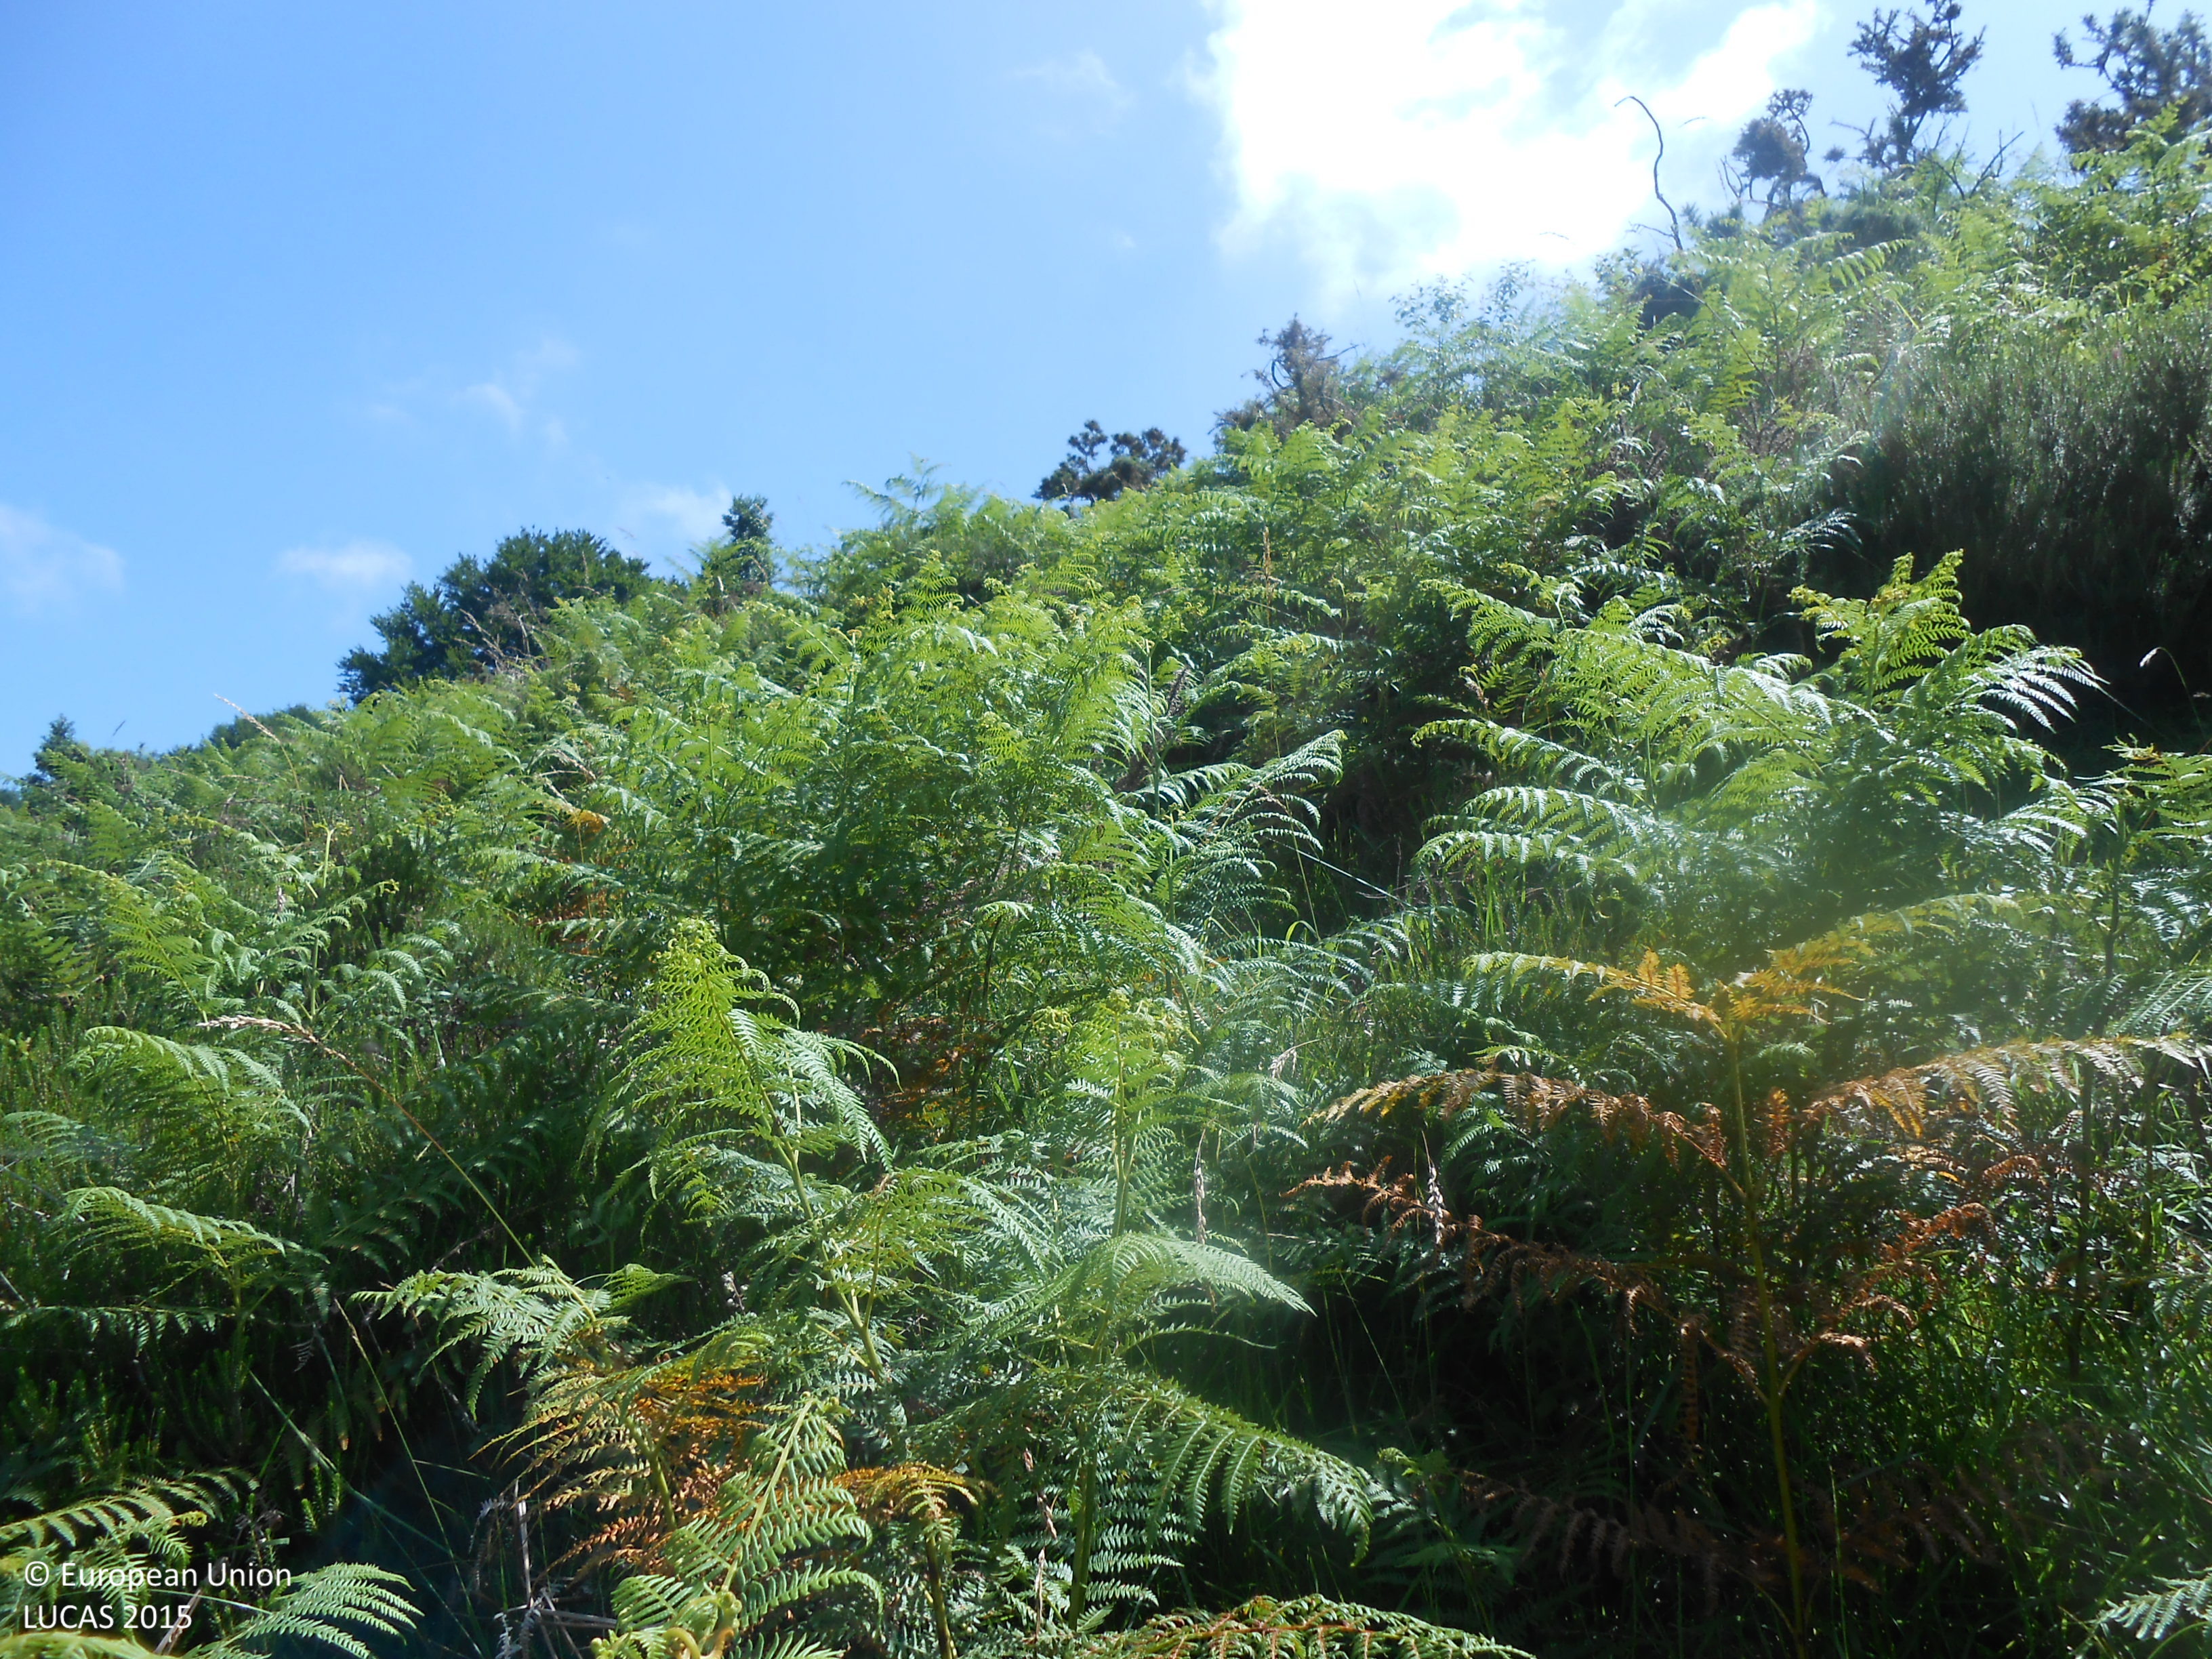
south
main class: Woodland
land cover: Broadleaved woodland
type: floodplain forest
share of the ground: > 75 %
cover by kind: broadleaved forest trees 100 %
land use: Forestry
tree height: > 5 m
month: June
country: ES
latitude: 43.2350
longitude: -1.5053
